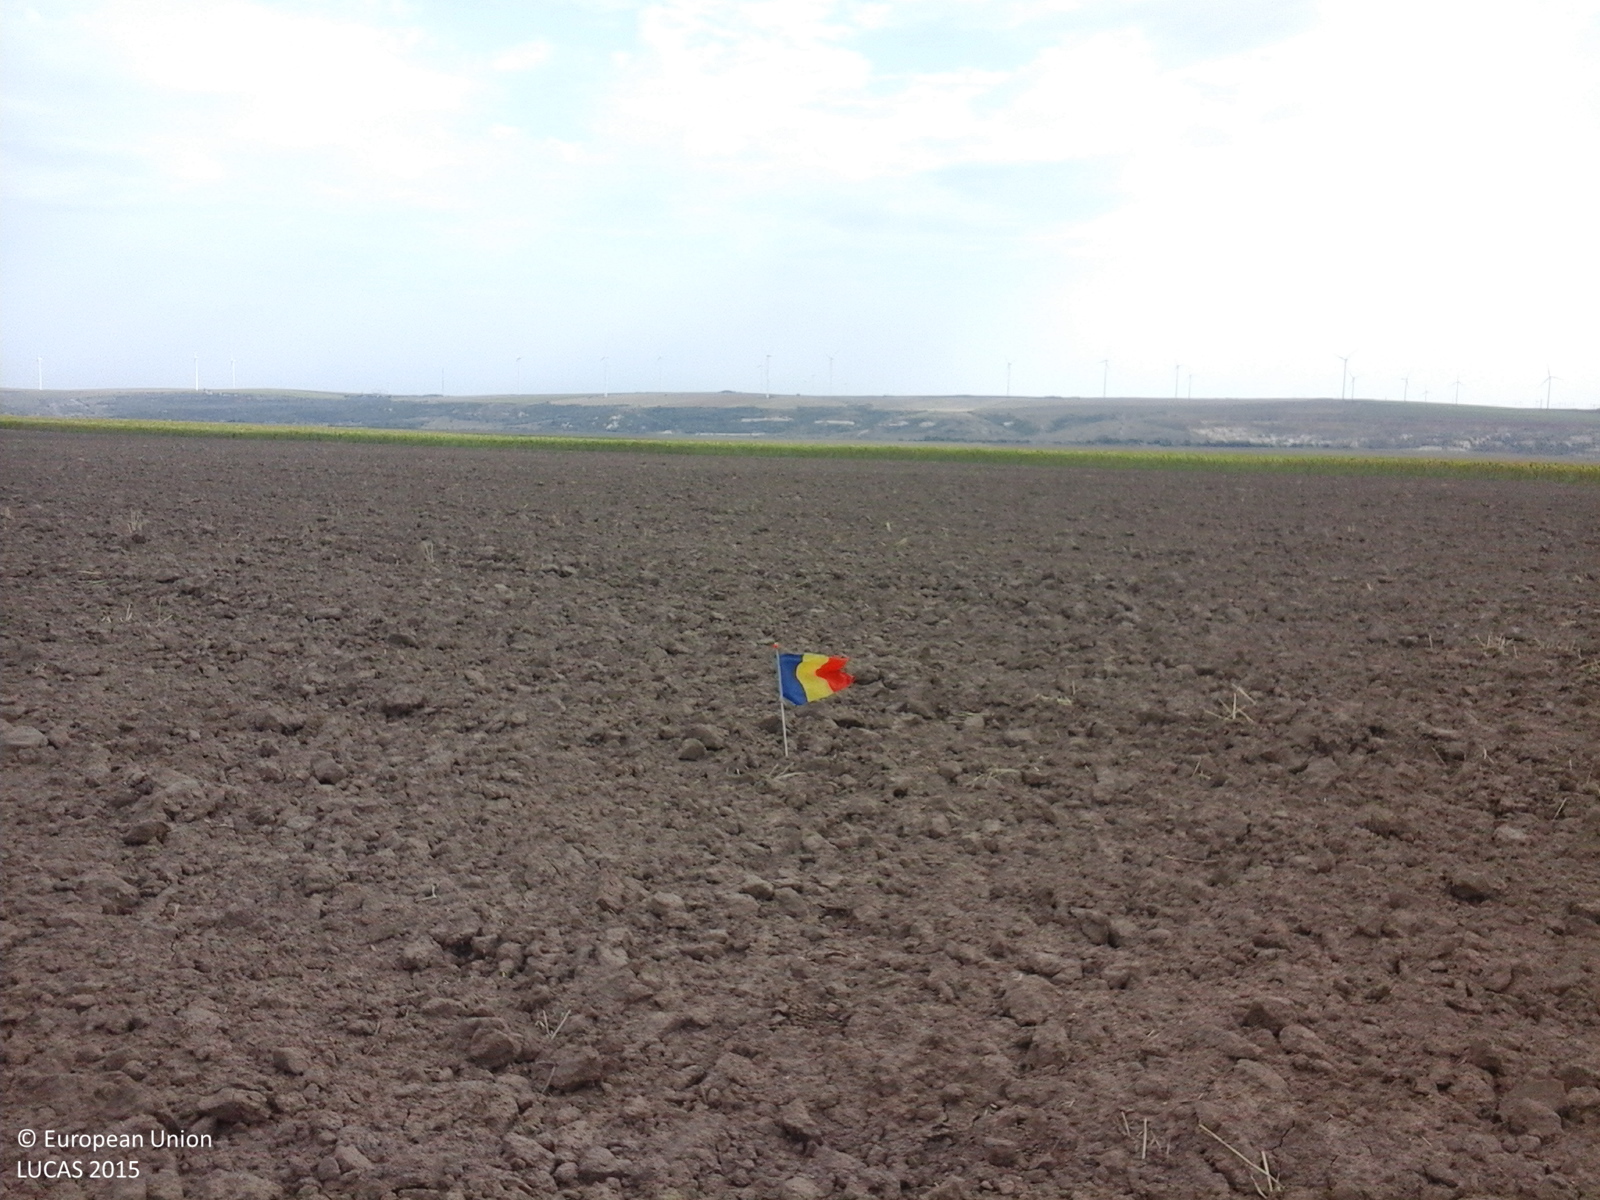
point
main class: Cropland
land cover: Common wheat
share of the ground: < 10 %
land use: Agriculture (excluding fallow land and kitchen gardens)
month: August
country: RO
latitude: 44.3545
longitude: 28.1645
